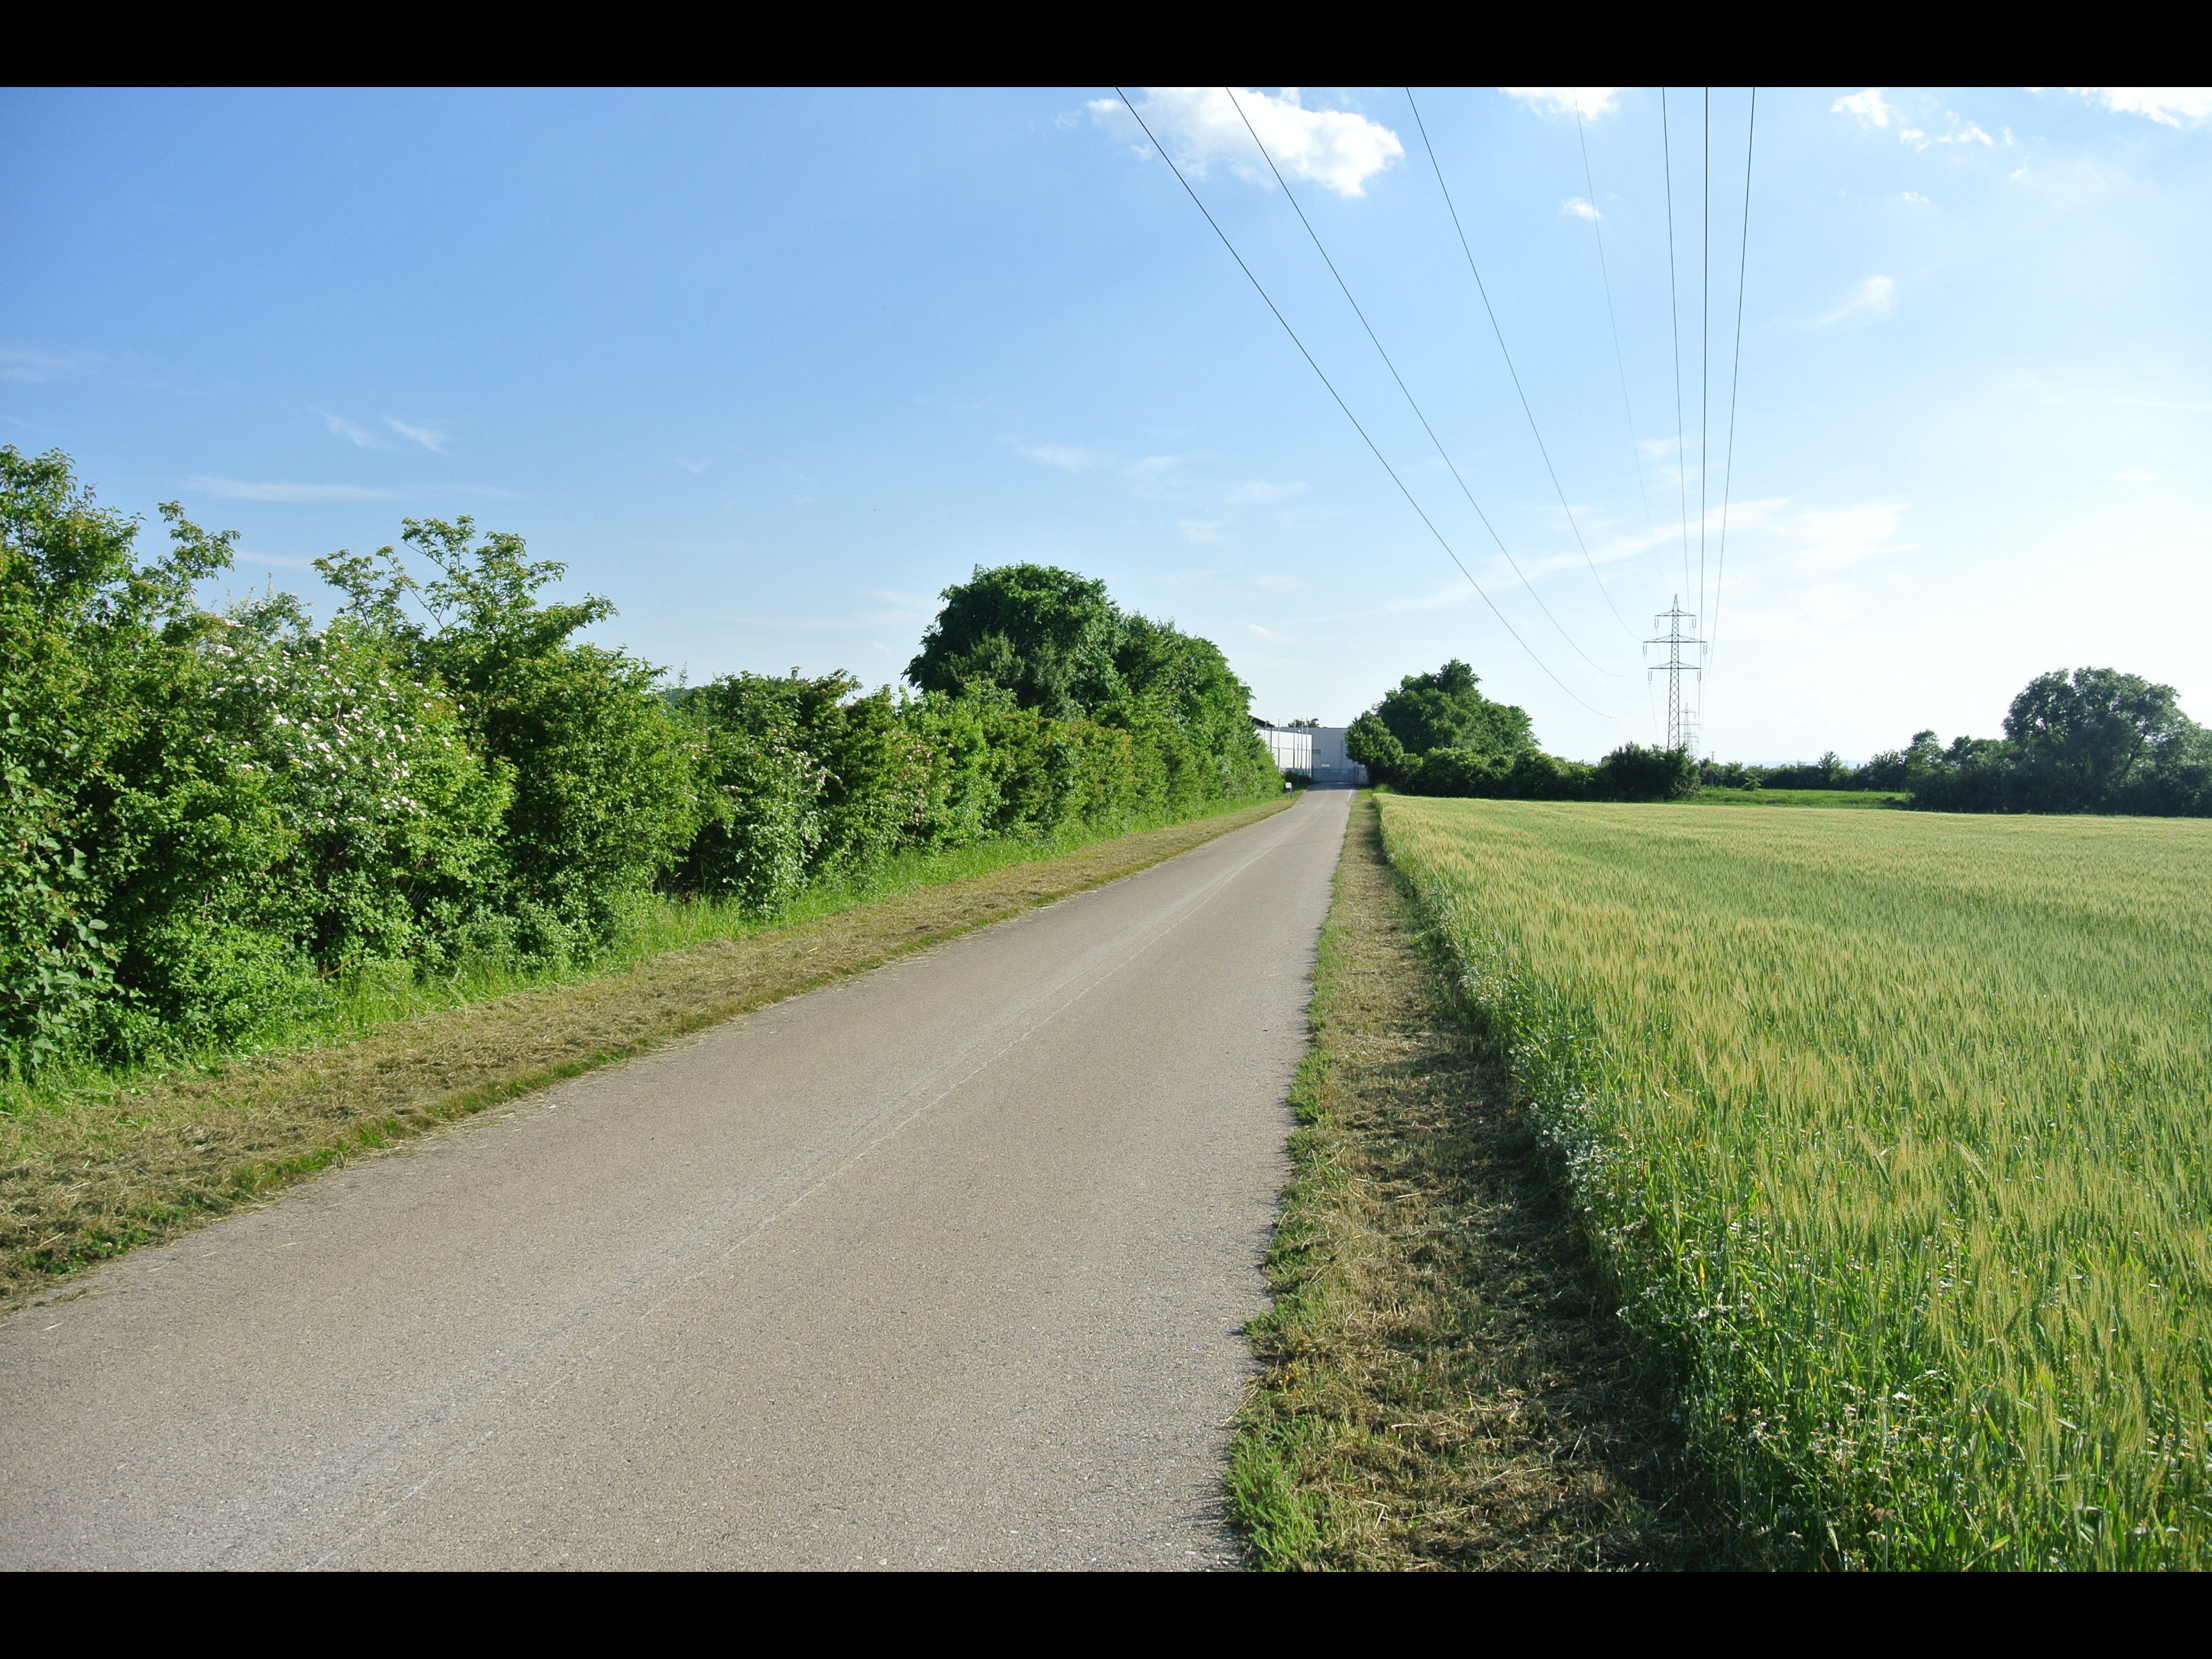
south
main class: Cropland
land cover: Triticale
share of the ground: > 75 %
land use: Agriculture (excluding fallow land and kitchen gardens)
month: June
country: AT
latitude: 47.8603
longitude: 16.6485
